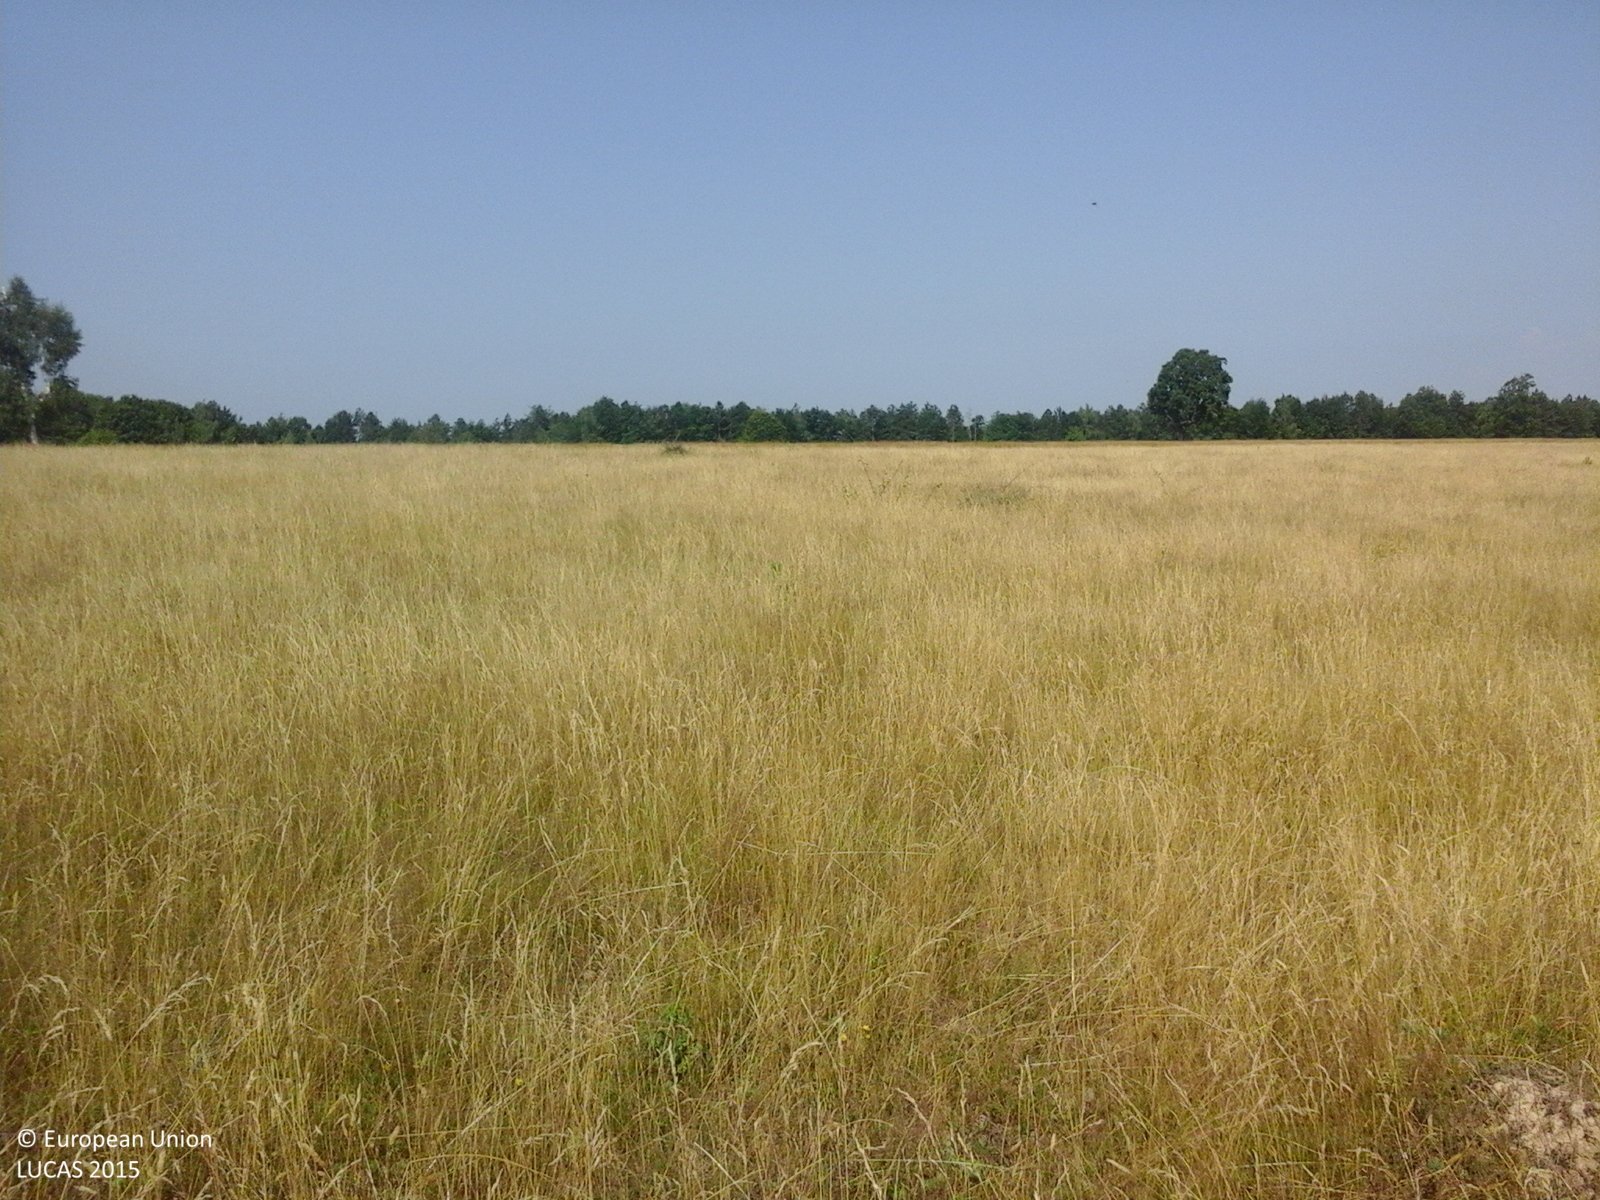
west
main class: Grassland
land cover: Grassland with sparse tree/shrub cover
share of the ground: > 75 %
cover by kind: herbaceous plants 85 %, shrubs 10 %, broadleaved forest trees 5 %
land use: Agriculture (excluding fallow land and kitchen gardens)
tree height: < 5 m
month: July
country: RO
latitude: 45.0302
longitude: 24.6108
